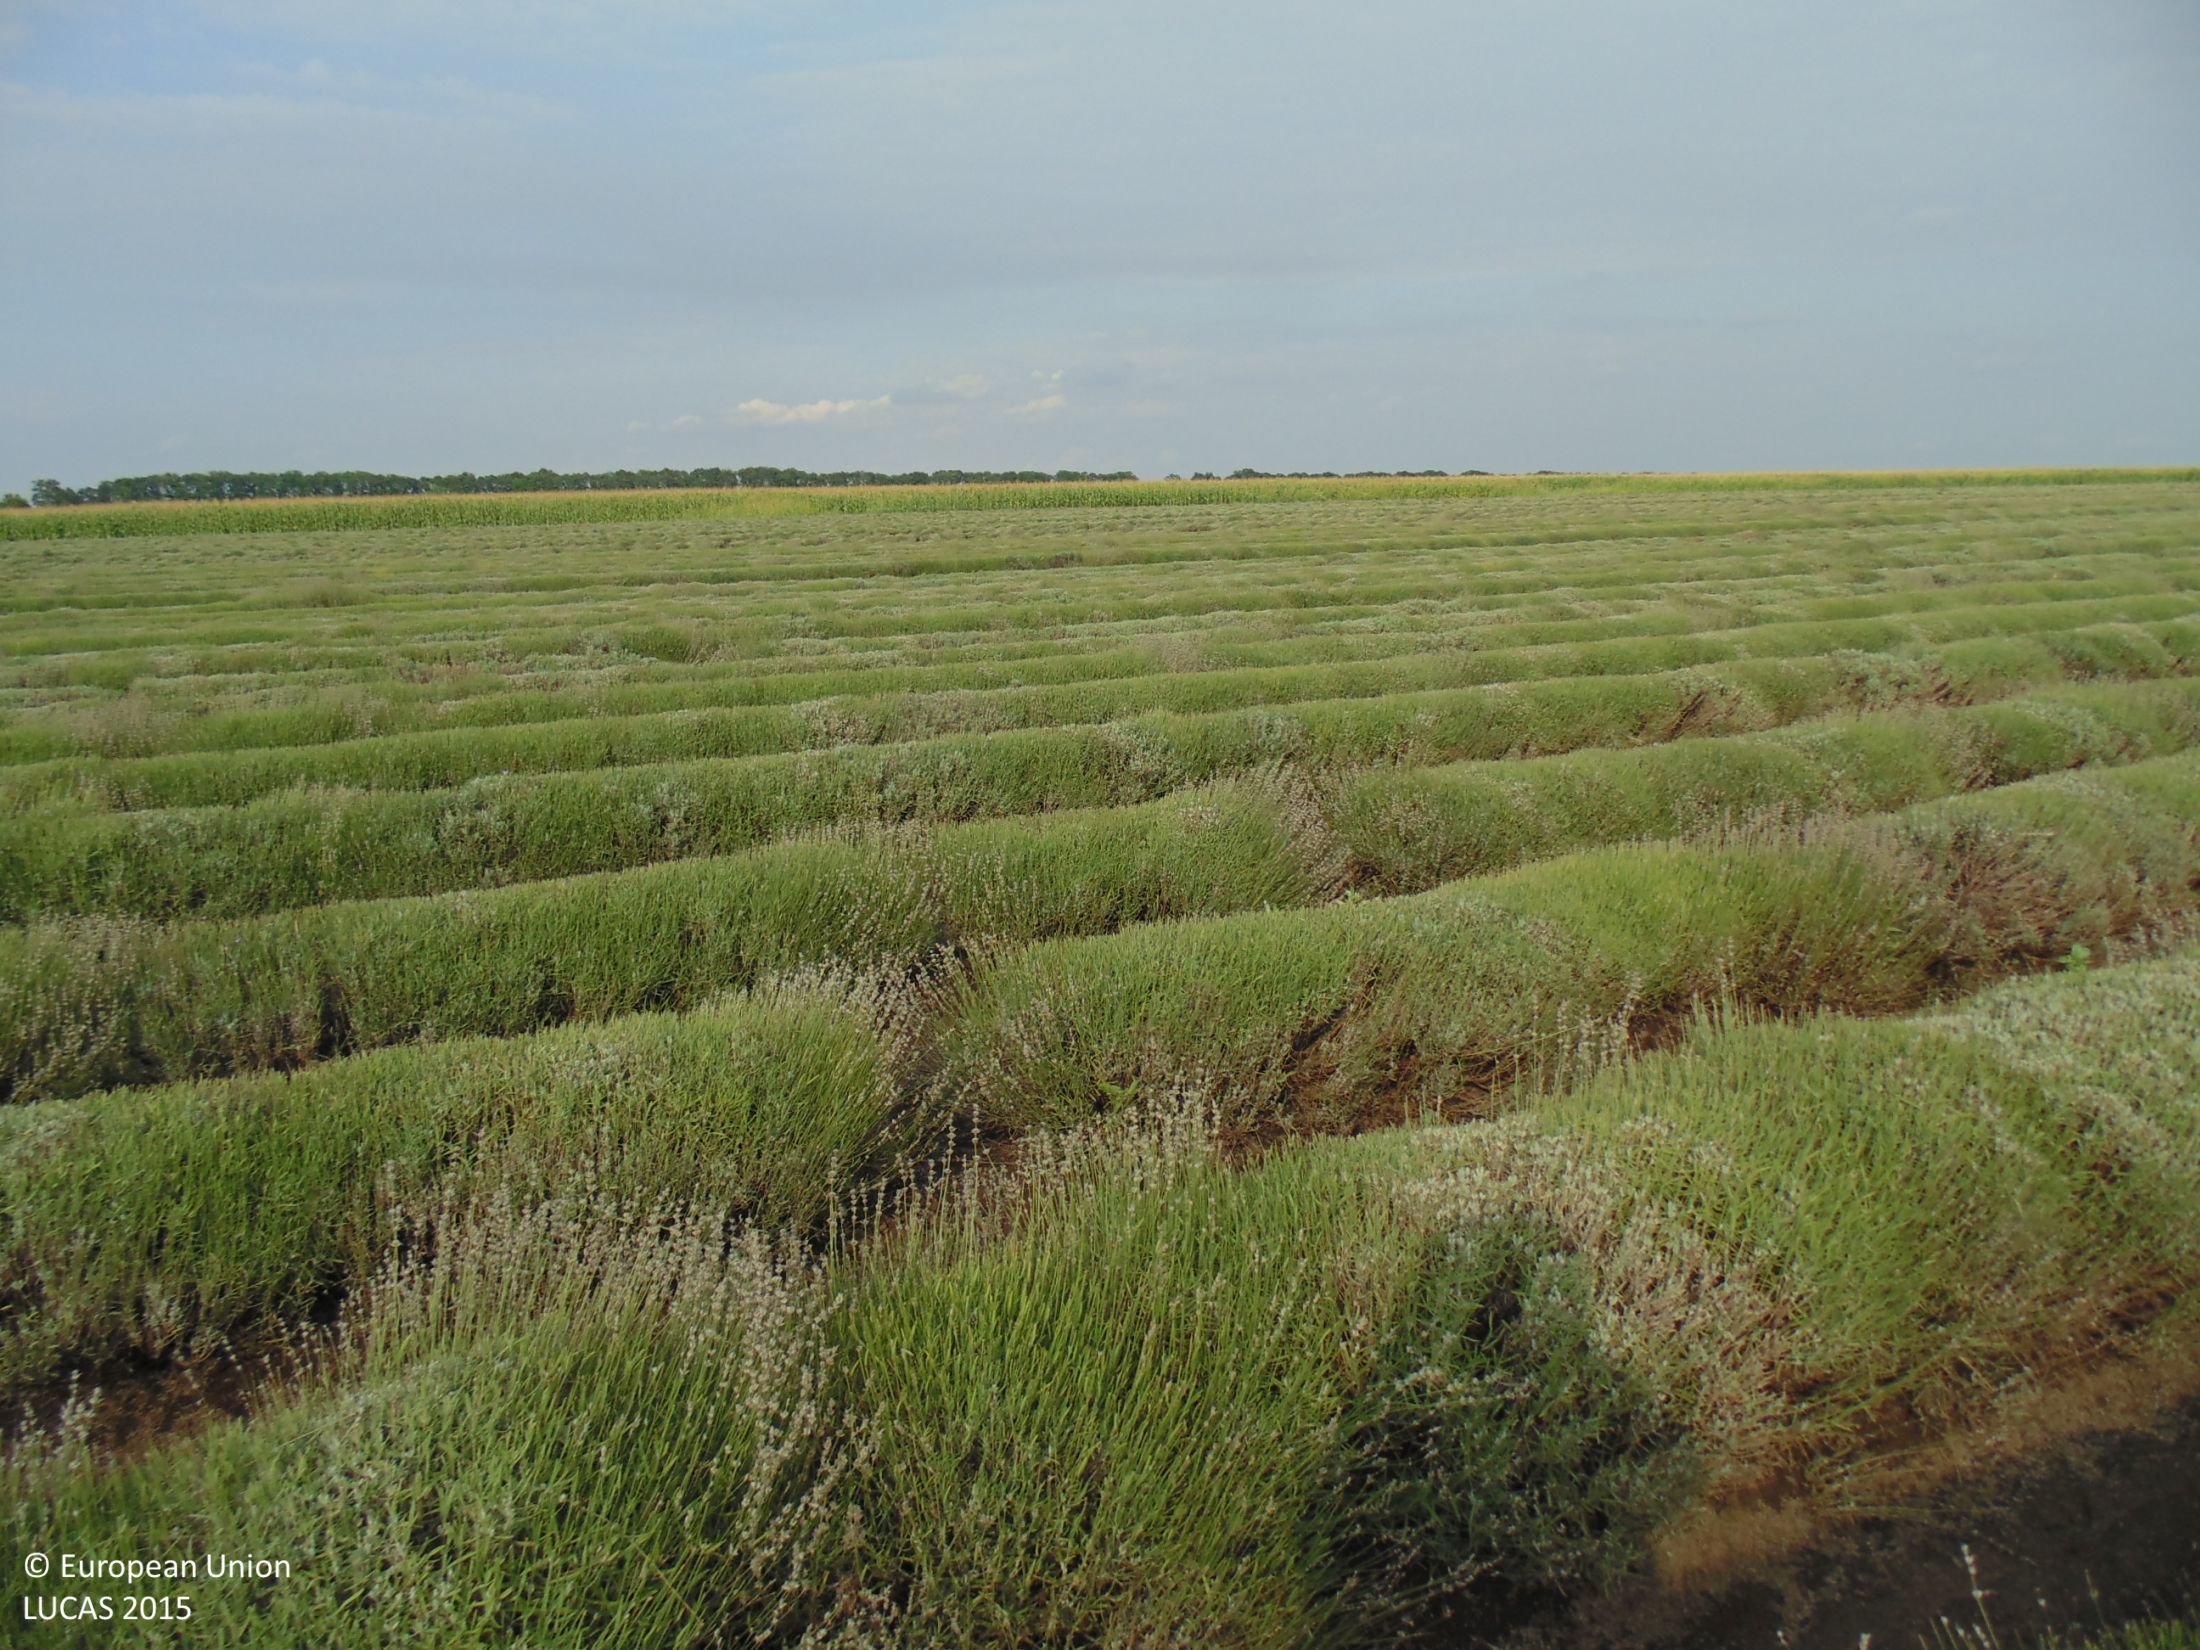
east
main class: Cropland
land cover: Other non-permanent industrial crops
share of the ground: > 75 %
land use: Agriculture (excluding fallow land and kitchen gardens)
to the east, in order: Other non-permanent industrial crops; Maize
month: August
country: BG
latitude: 43.7703
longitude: 28.0266
